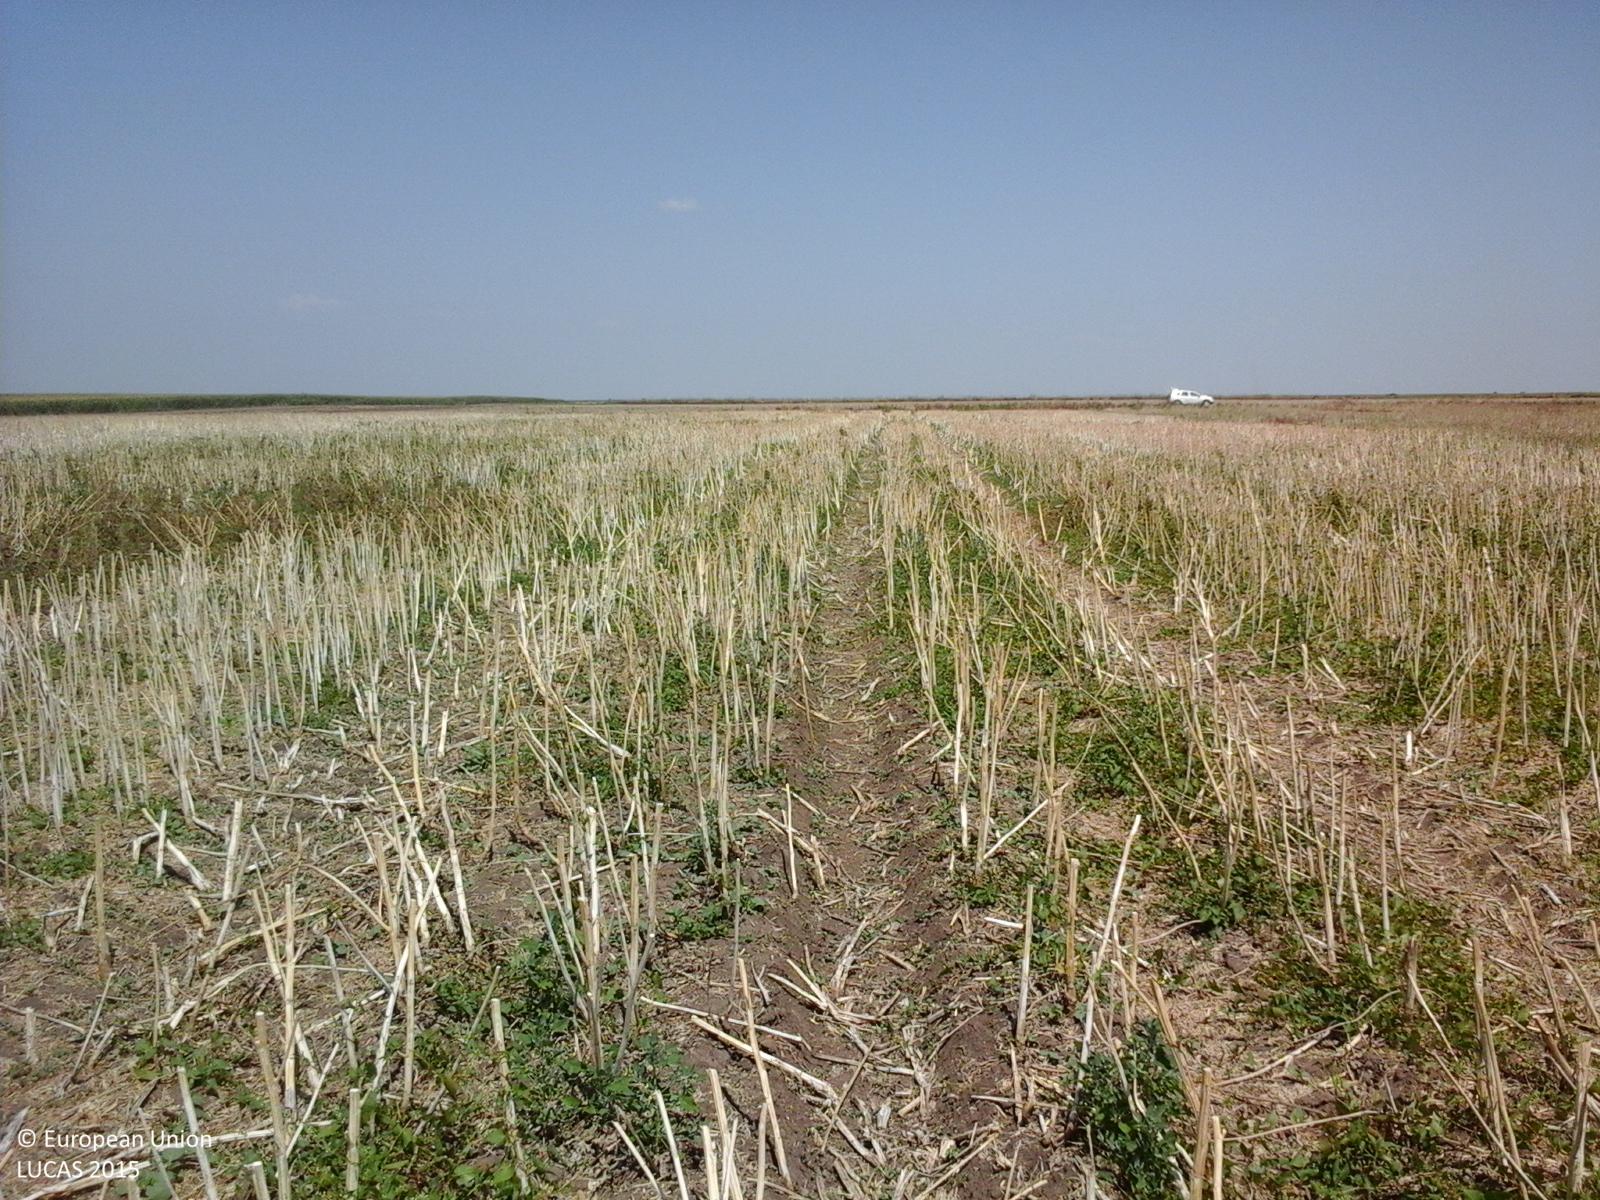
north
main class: Cropland
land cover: Rape and turnip rape
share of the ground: < 10 %
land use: Agriculture (excluding fallow land and kitchen gardens)
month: July
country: RO
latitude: 44.4838
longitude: 27.0929
